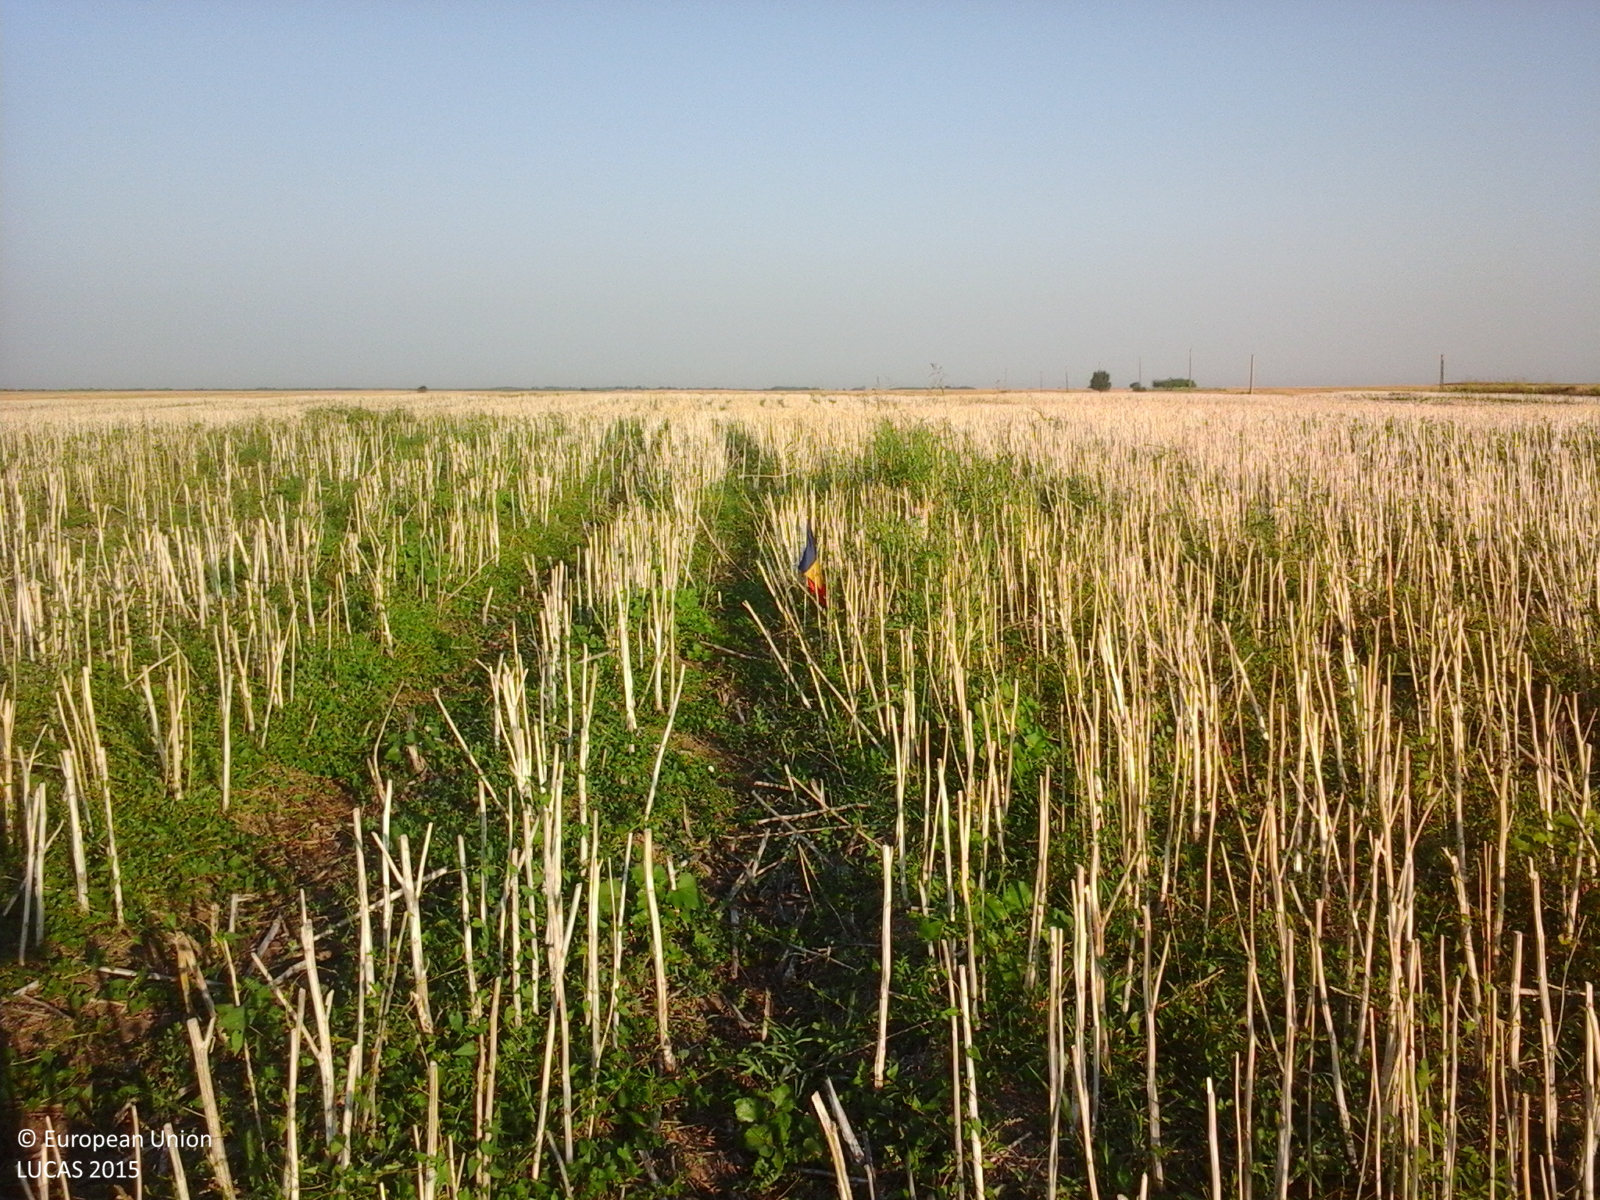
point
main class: Cropland
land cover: Rape and turnip rape
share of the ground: < 10 %
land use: Agriculture (excluding fallow land and kitchen gardens)
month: July
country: RO
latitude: 44.5239
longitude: 27.1830
